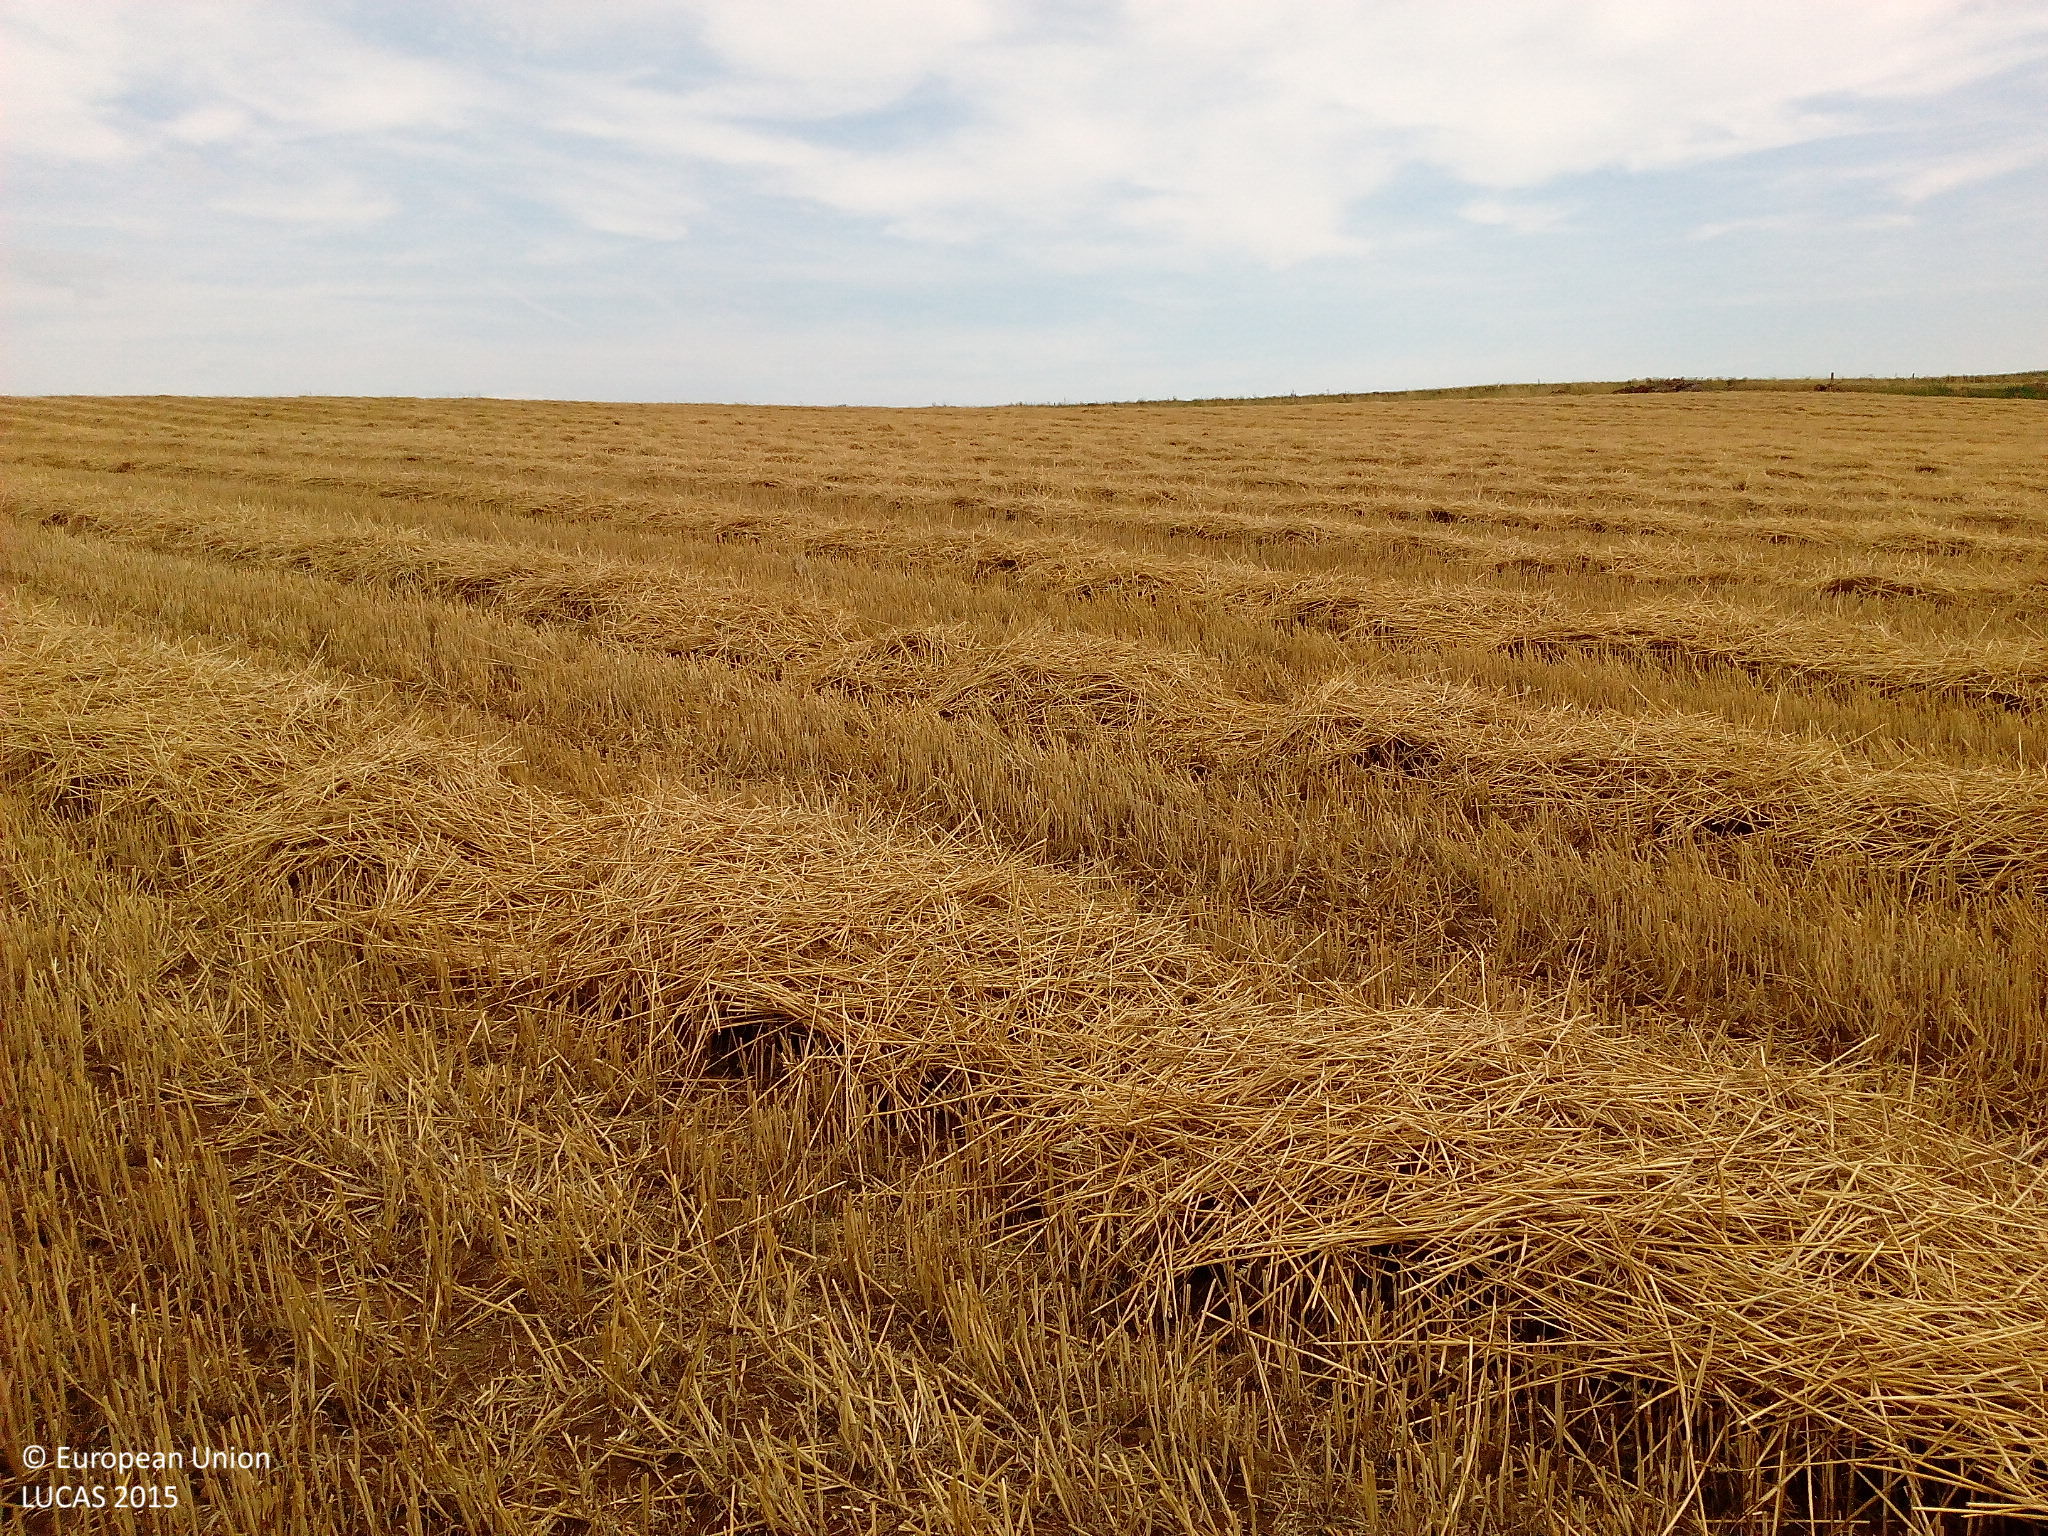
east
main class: Cropland
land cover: Barley
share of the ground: < 10 %
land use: Agriculture (excluding fallow land and kitchen gardens)
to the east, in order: Barley; Grass margins; Paved roads, cycling and walking lanes; Grass margins; Ditches and canals; Grassland without tree/shrub cover
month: August
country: DE
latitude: 50.6667
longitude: 9.1655
